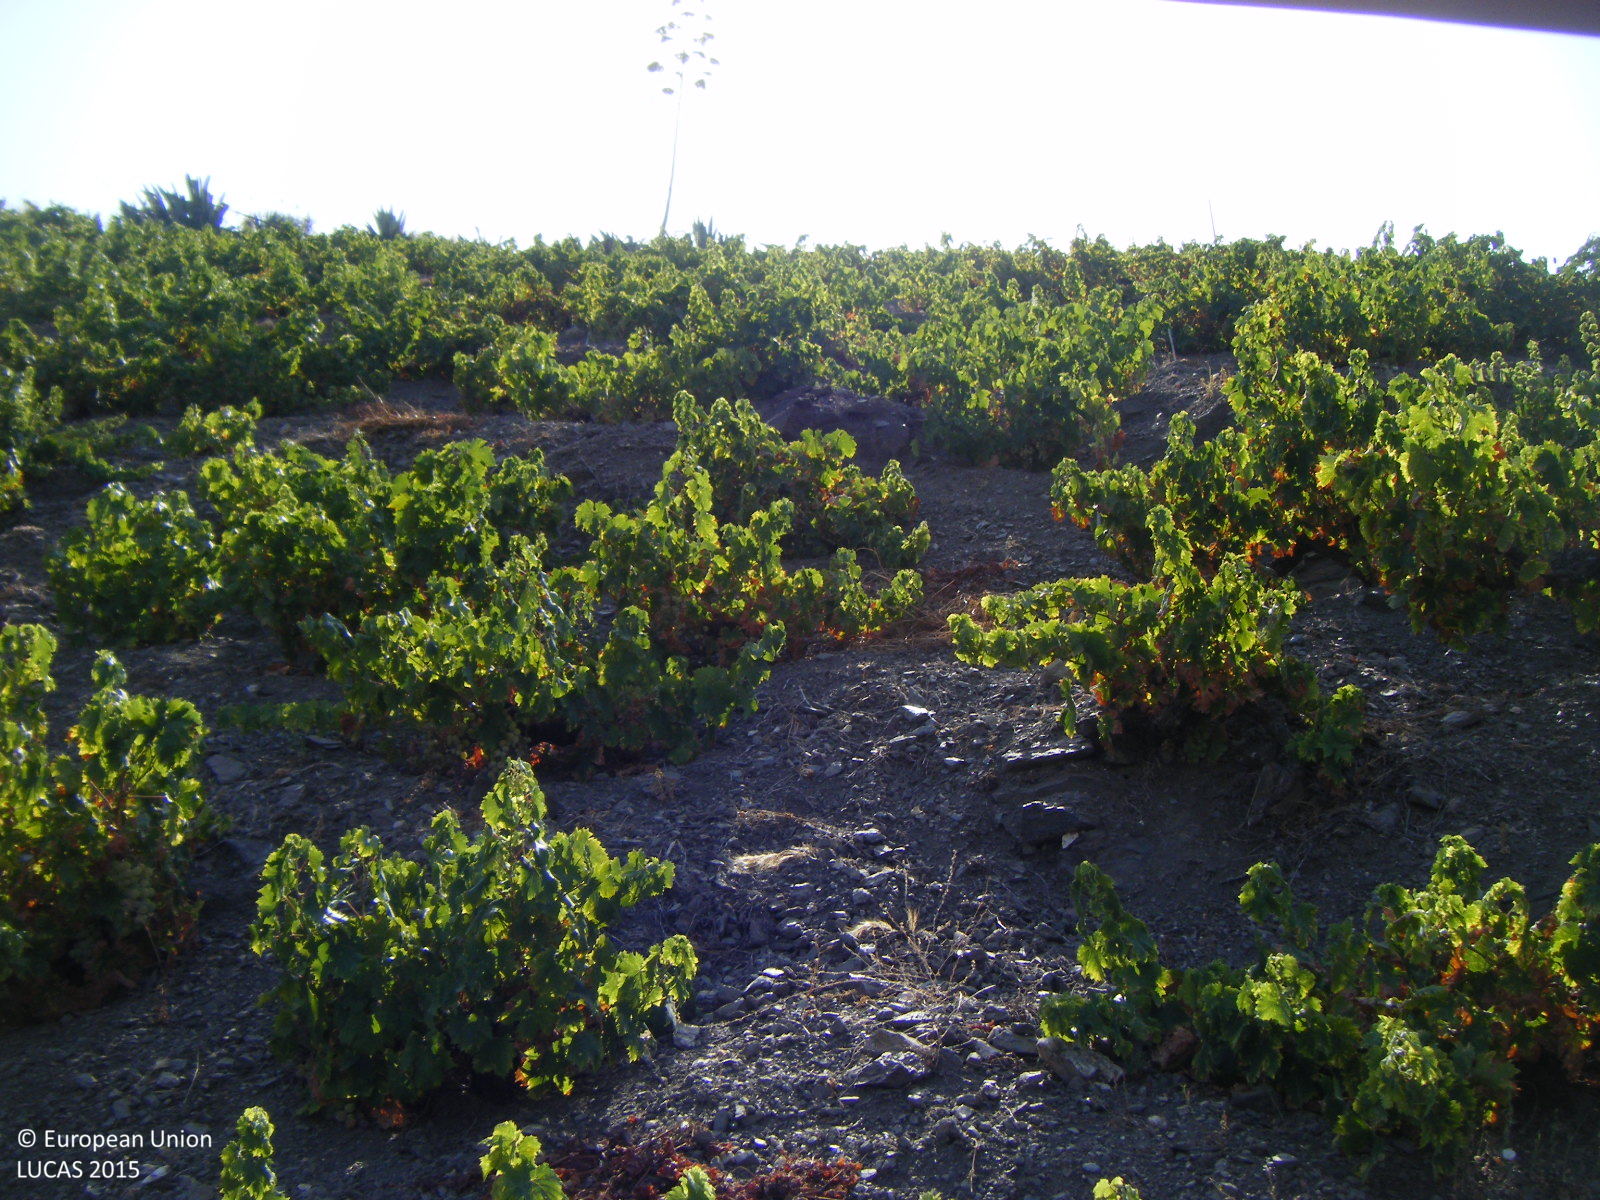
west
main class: Cropland
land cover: Vineyards
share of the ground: 10 - 25 %
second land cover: Other bare soil
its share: > 75 %
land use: Agriculture (excluding fallow land and kitchen gardens)
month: July
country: ES
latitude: 36.8174
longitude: -4.2378
